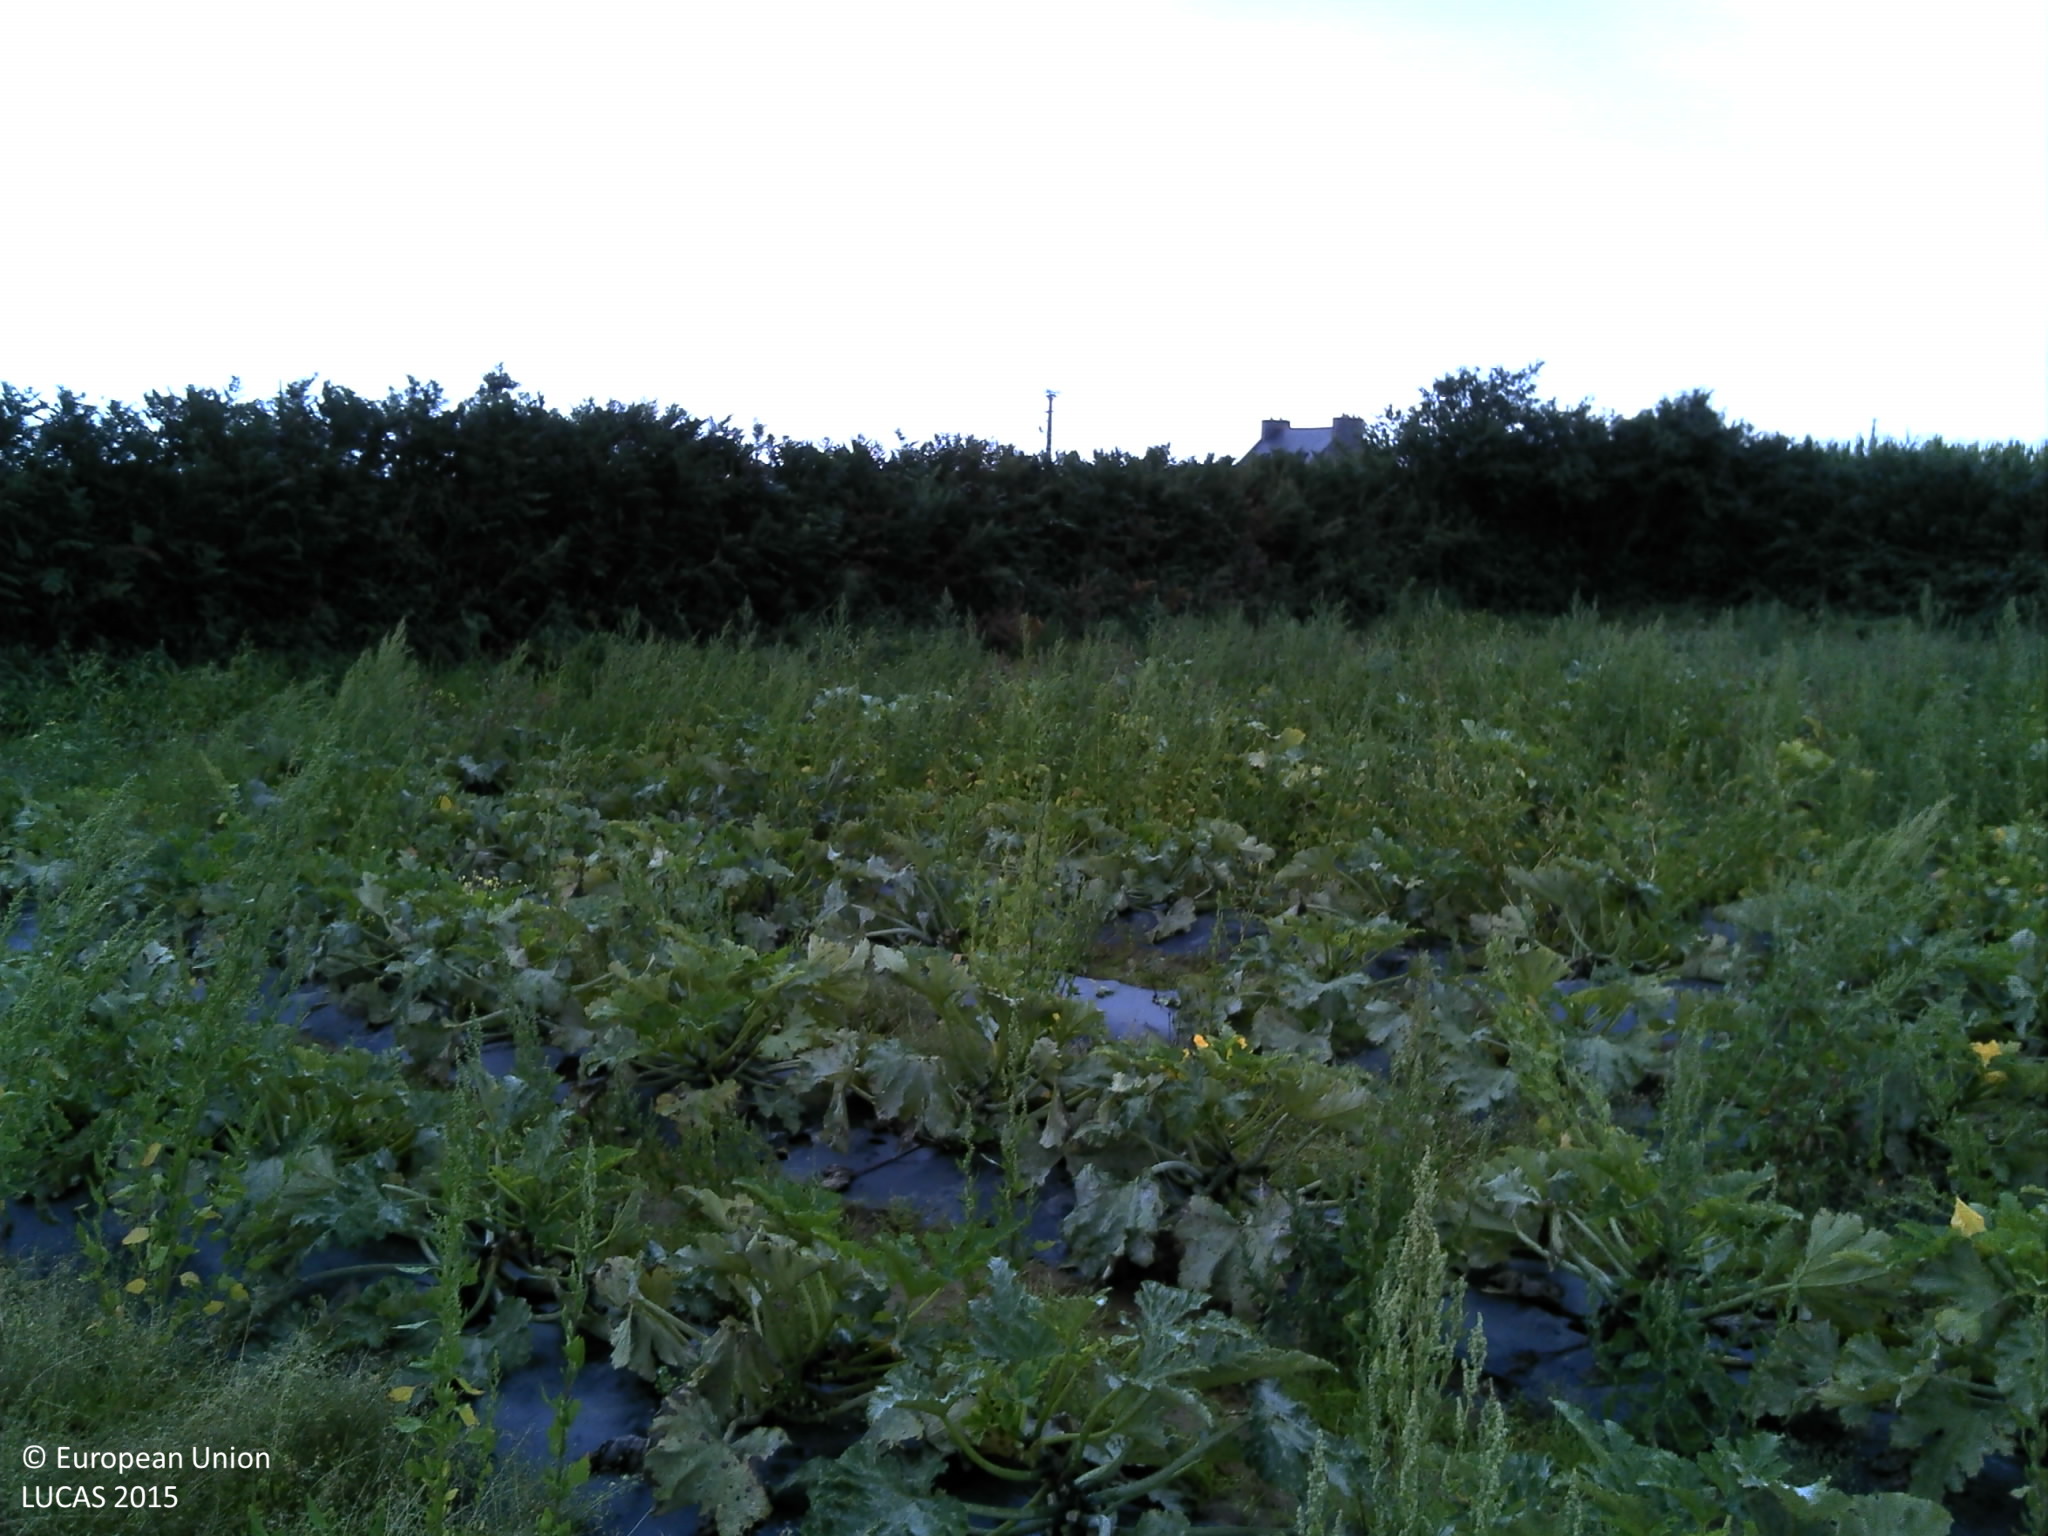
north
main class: Cropland
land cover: Other fresh vegetables
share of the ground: 50 - 75 %
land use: Agriculture (excluding fallow land and kitchen gardens)
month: August
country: FR
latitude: 48.6088
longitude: -4.5172
